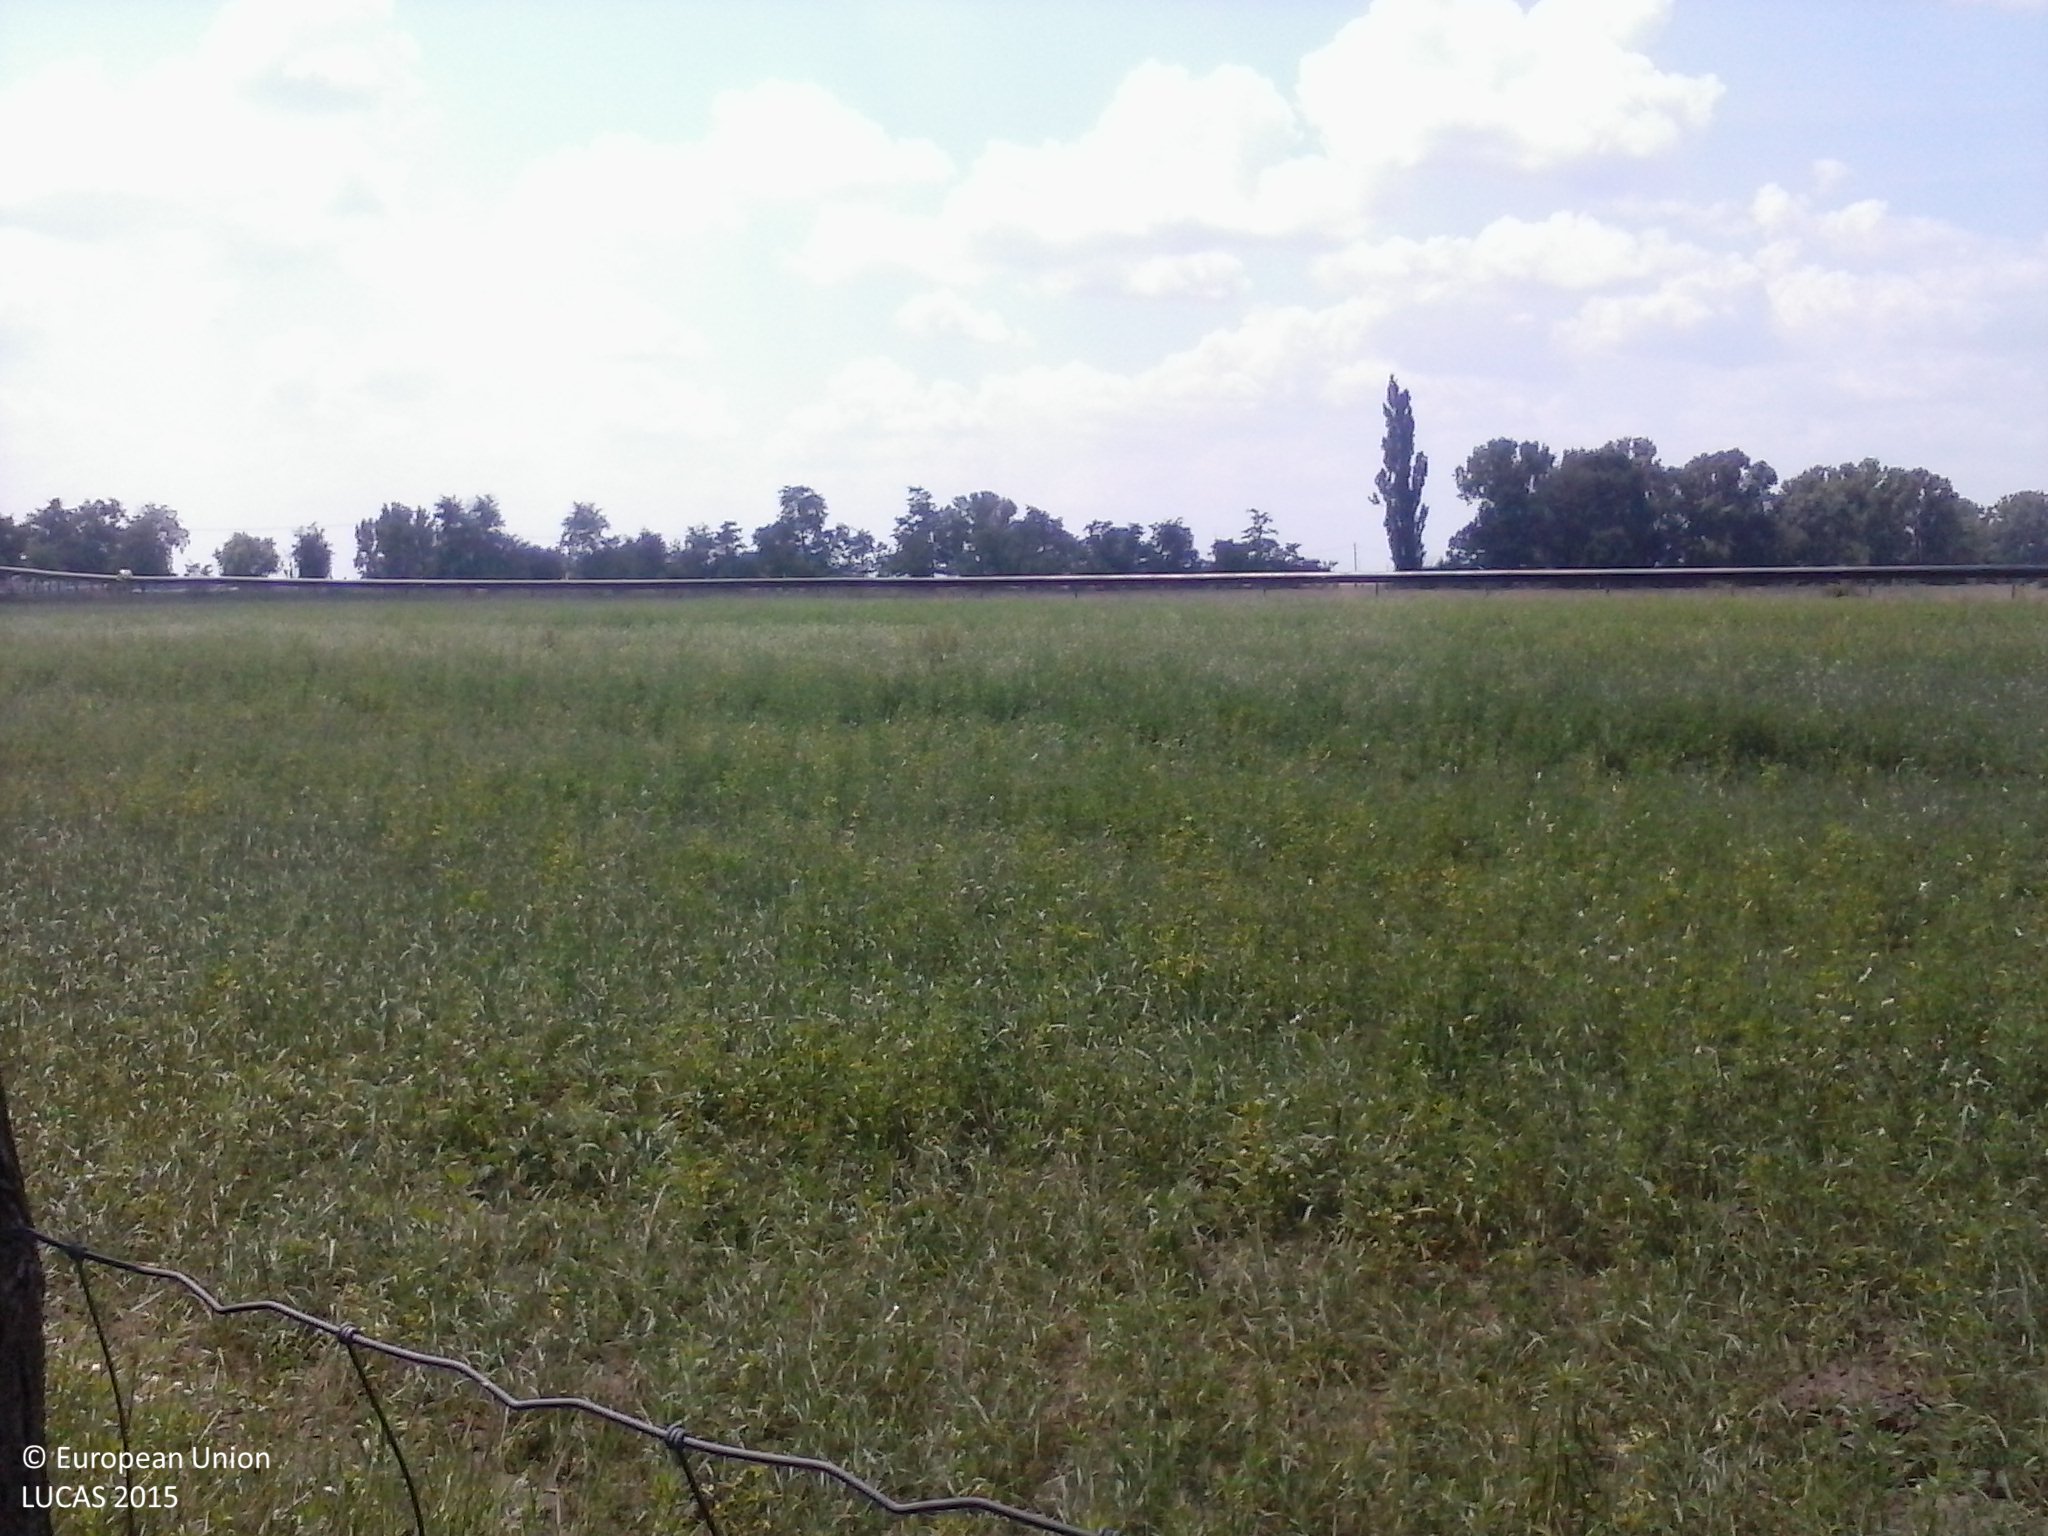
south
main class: Cropland
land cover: Lucerne
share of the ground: > 75 %
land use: Agriculture (excluding fallow land and kitchen gardens)
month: July
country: HU
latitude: 46.2850
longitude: 19.5567
